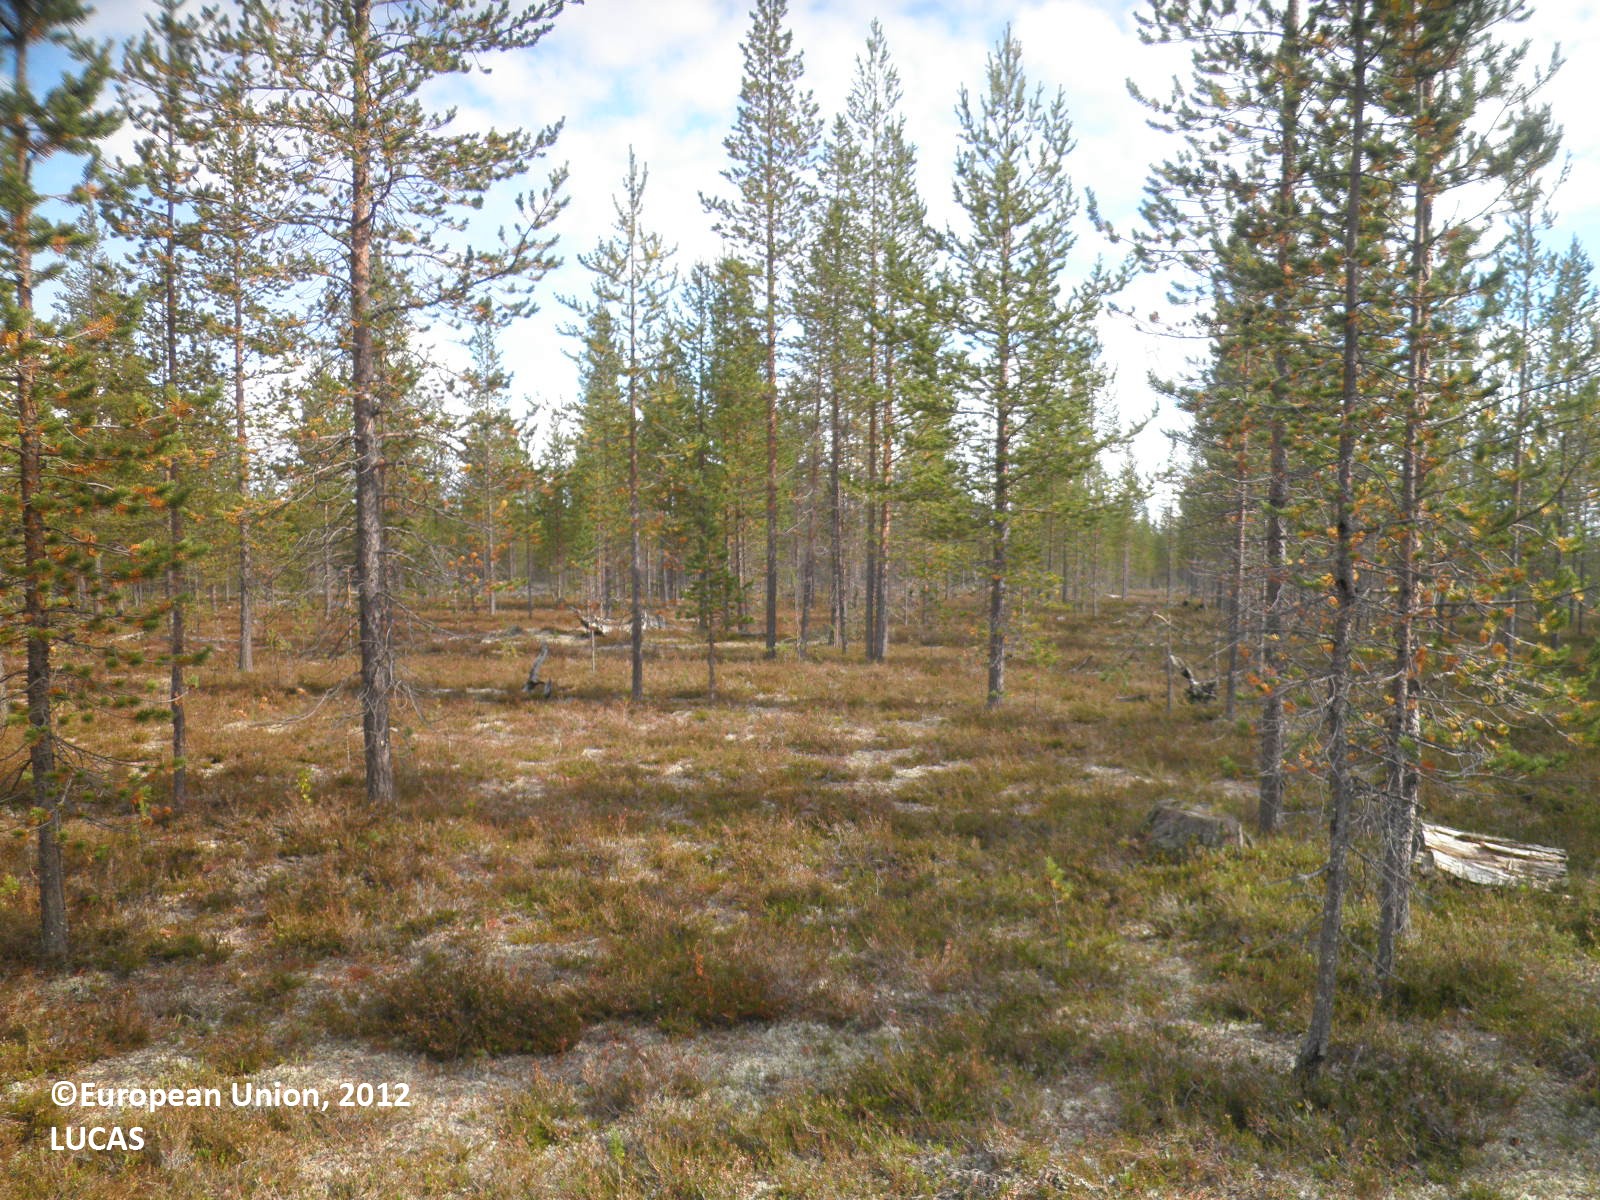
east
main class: Woodland
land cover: Pine dominated coniferous woodland
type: boreal forest
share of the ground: 25 - 50 %
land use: Forestry
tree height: > 5 m
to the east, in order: Pine dominated coniferous woodland; Shrubland with sparse tree cover; Pine dominated coniferous woodland
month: August
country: FI
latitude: 67.9876
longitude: 28.2086
